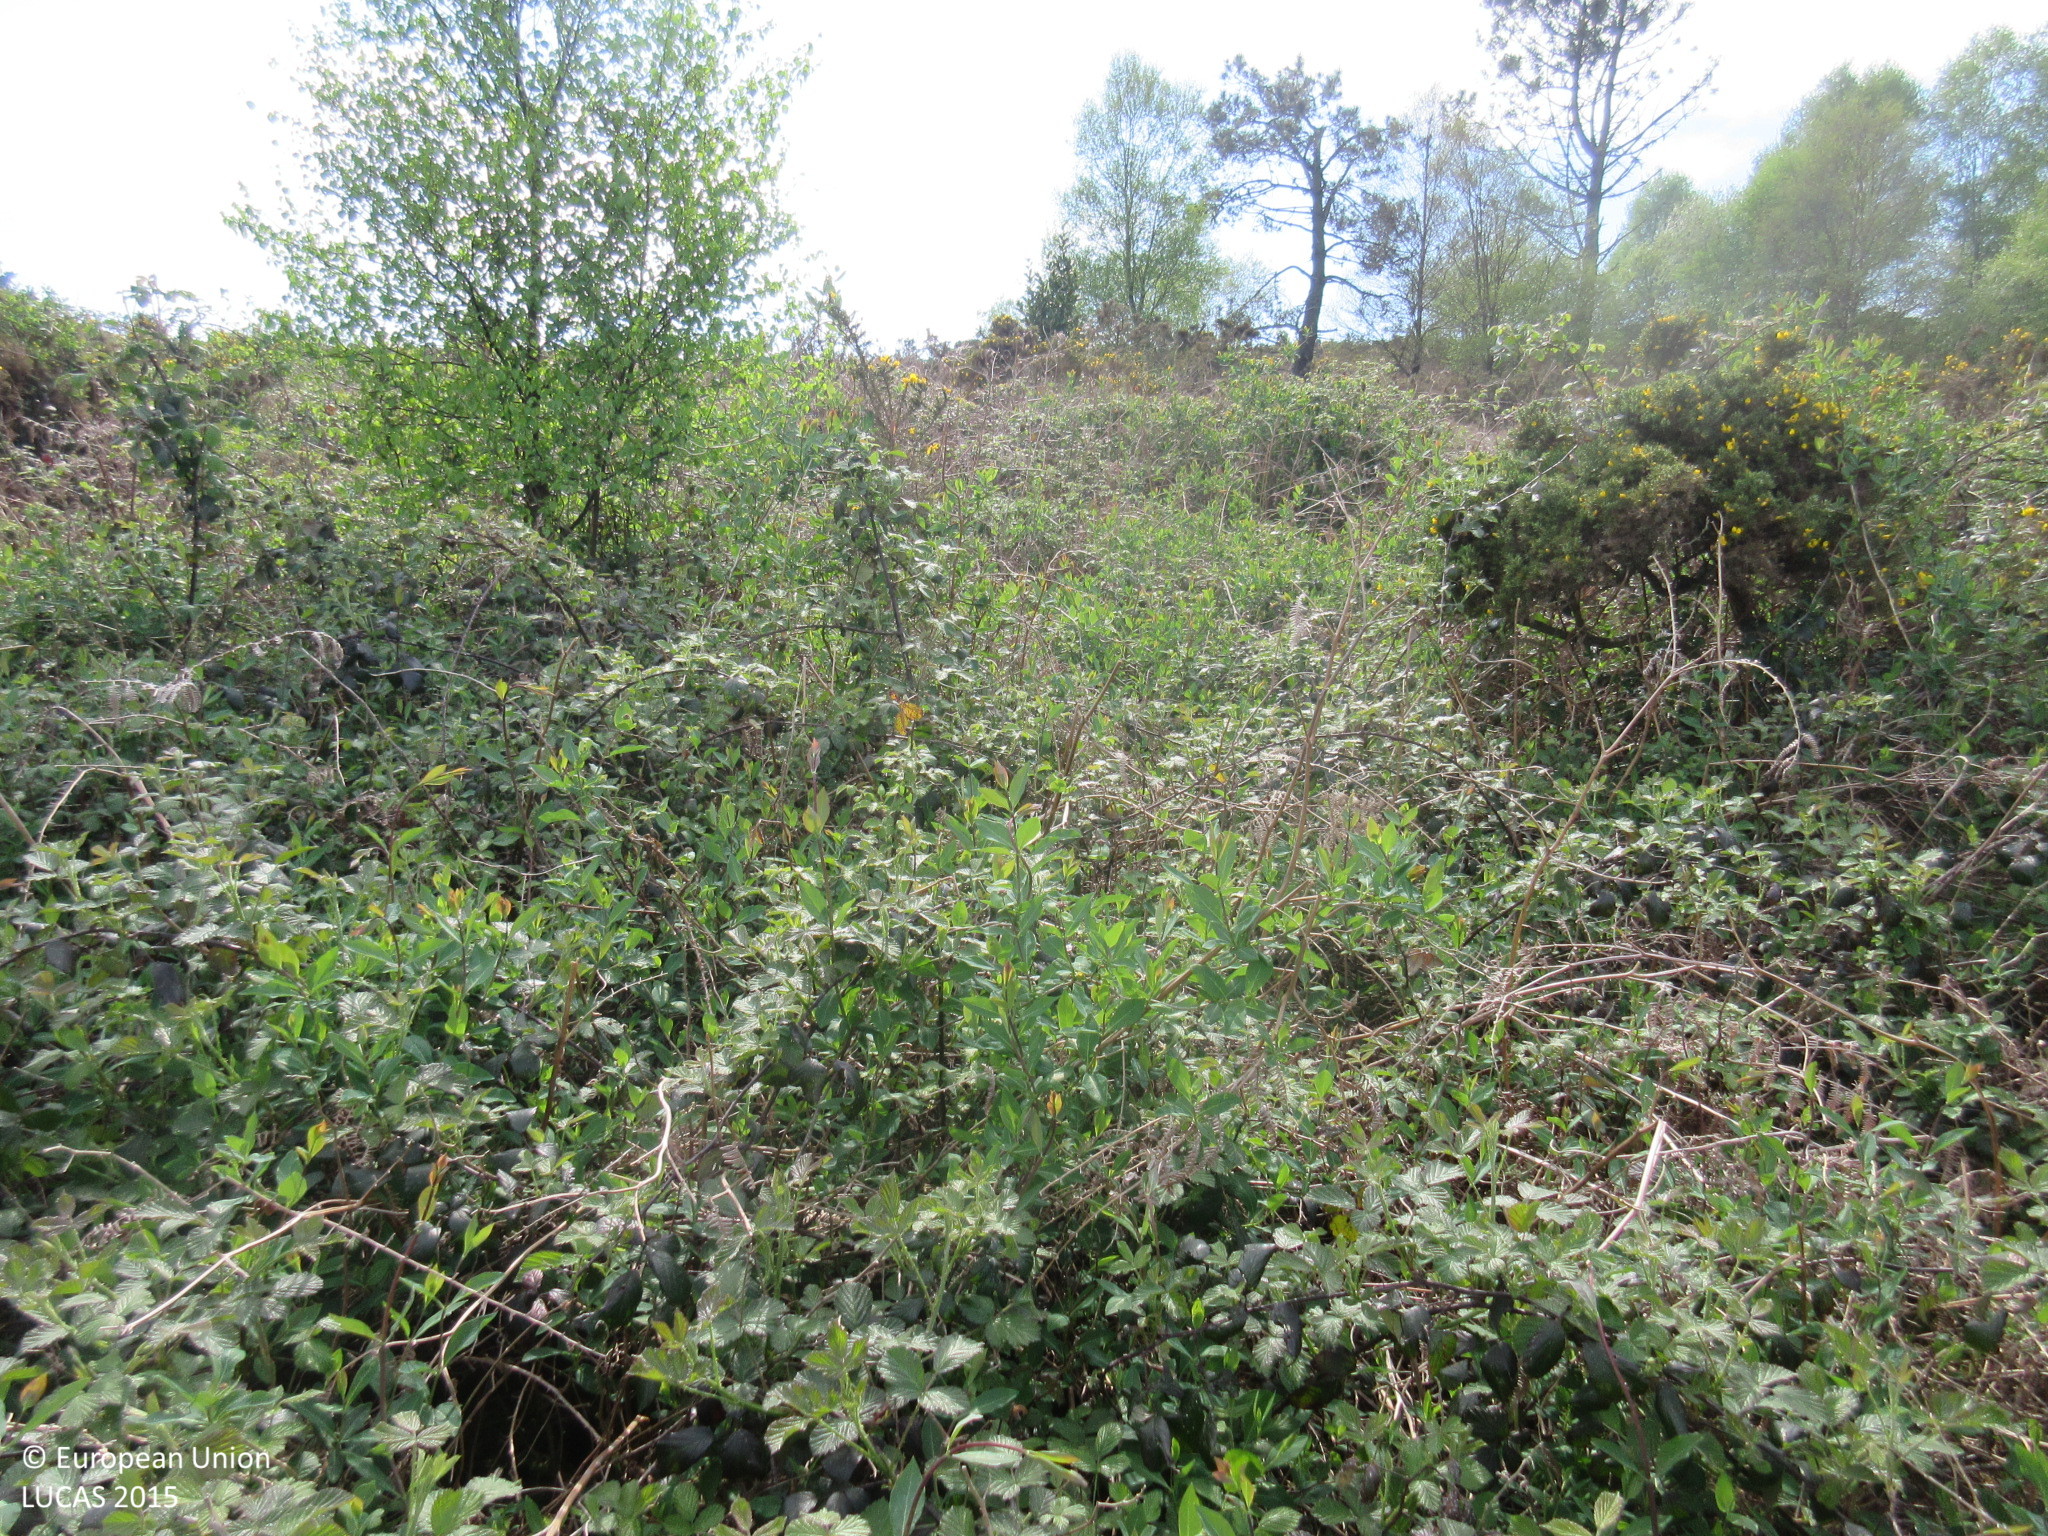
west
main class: Shrubland
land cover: Shrubland without tree cover
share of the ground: > 75 %
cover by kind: shrubs 100 %
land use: Semi-natural and natural areas not in use
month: April
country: ES
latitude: 43.4396
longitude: -6.9556
